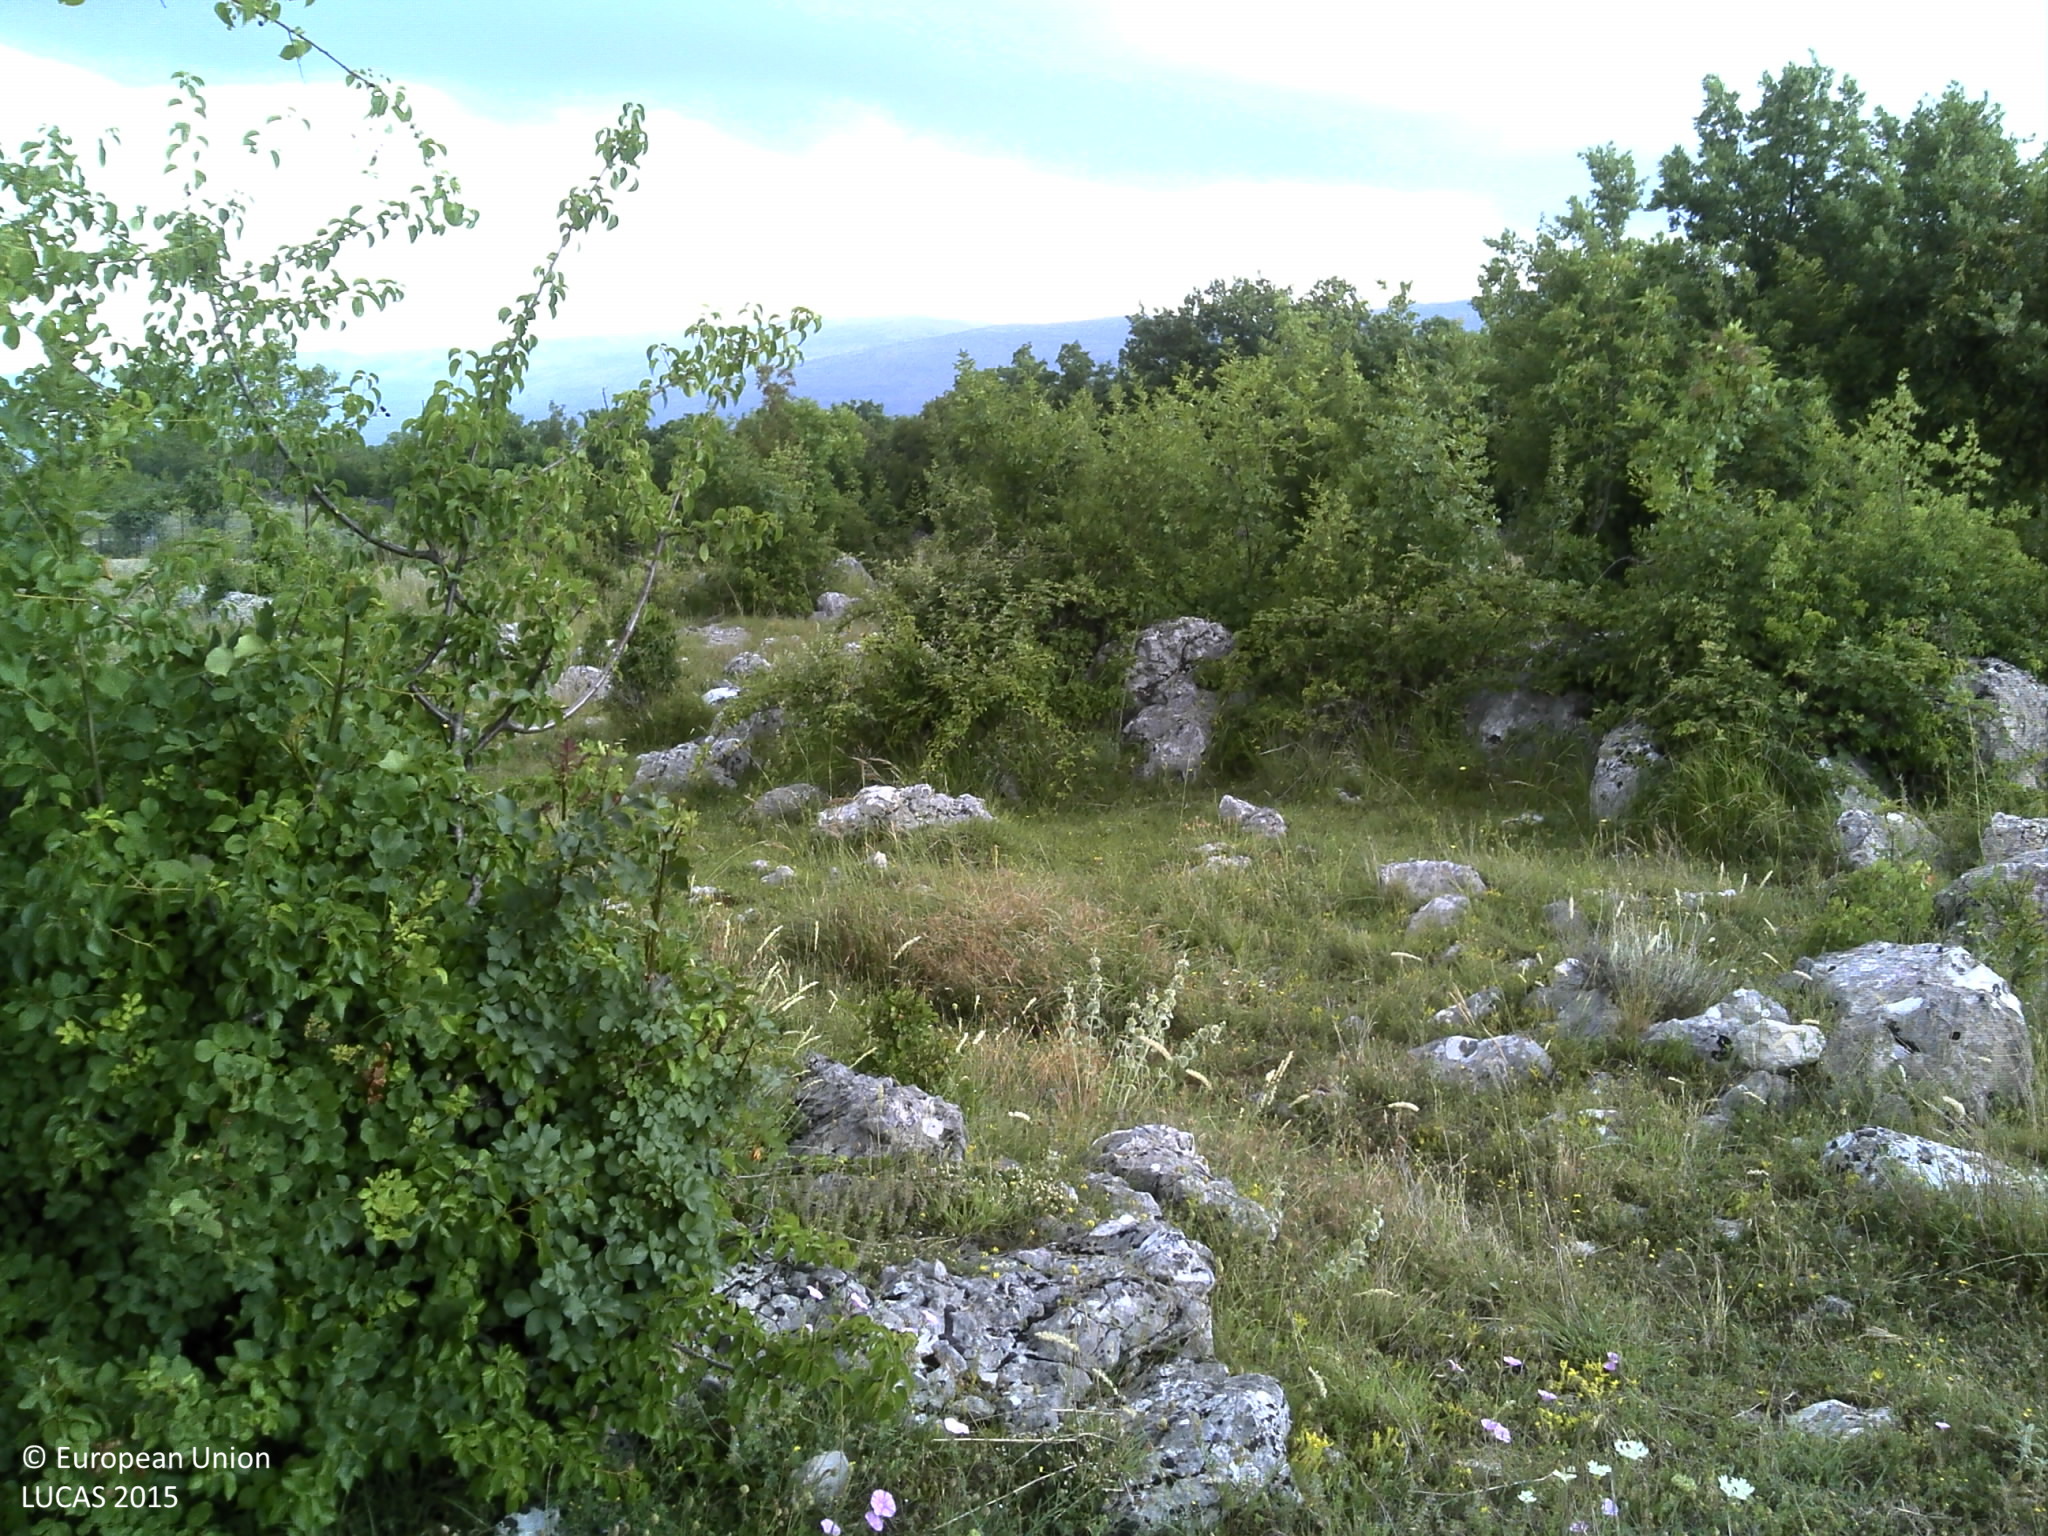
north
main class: Grassland
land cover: Grassland with sparse tree/shrub cover
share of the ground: 50 - 75 %
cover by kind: herbaceous plants 65 %, unconsolidated bare surface 20 %, broadleaved forest trees 5 %, shrubs 5 %, consolidated bare surface 5 %
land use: Abandoned areas
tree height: > 5 m
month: June
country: HR
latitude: 43.7955
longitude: 16.6165
